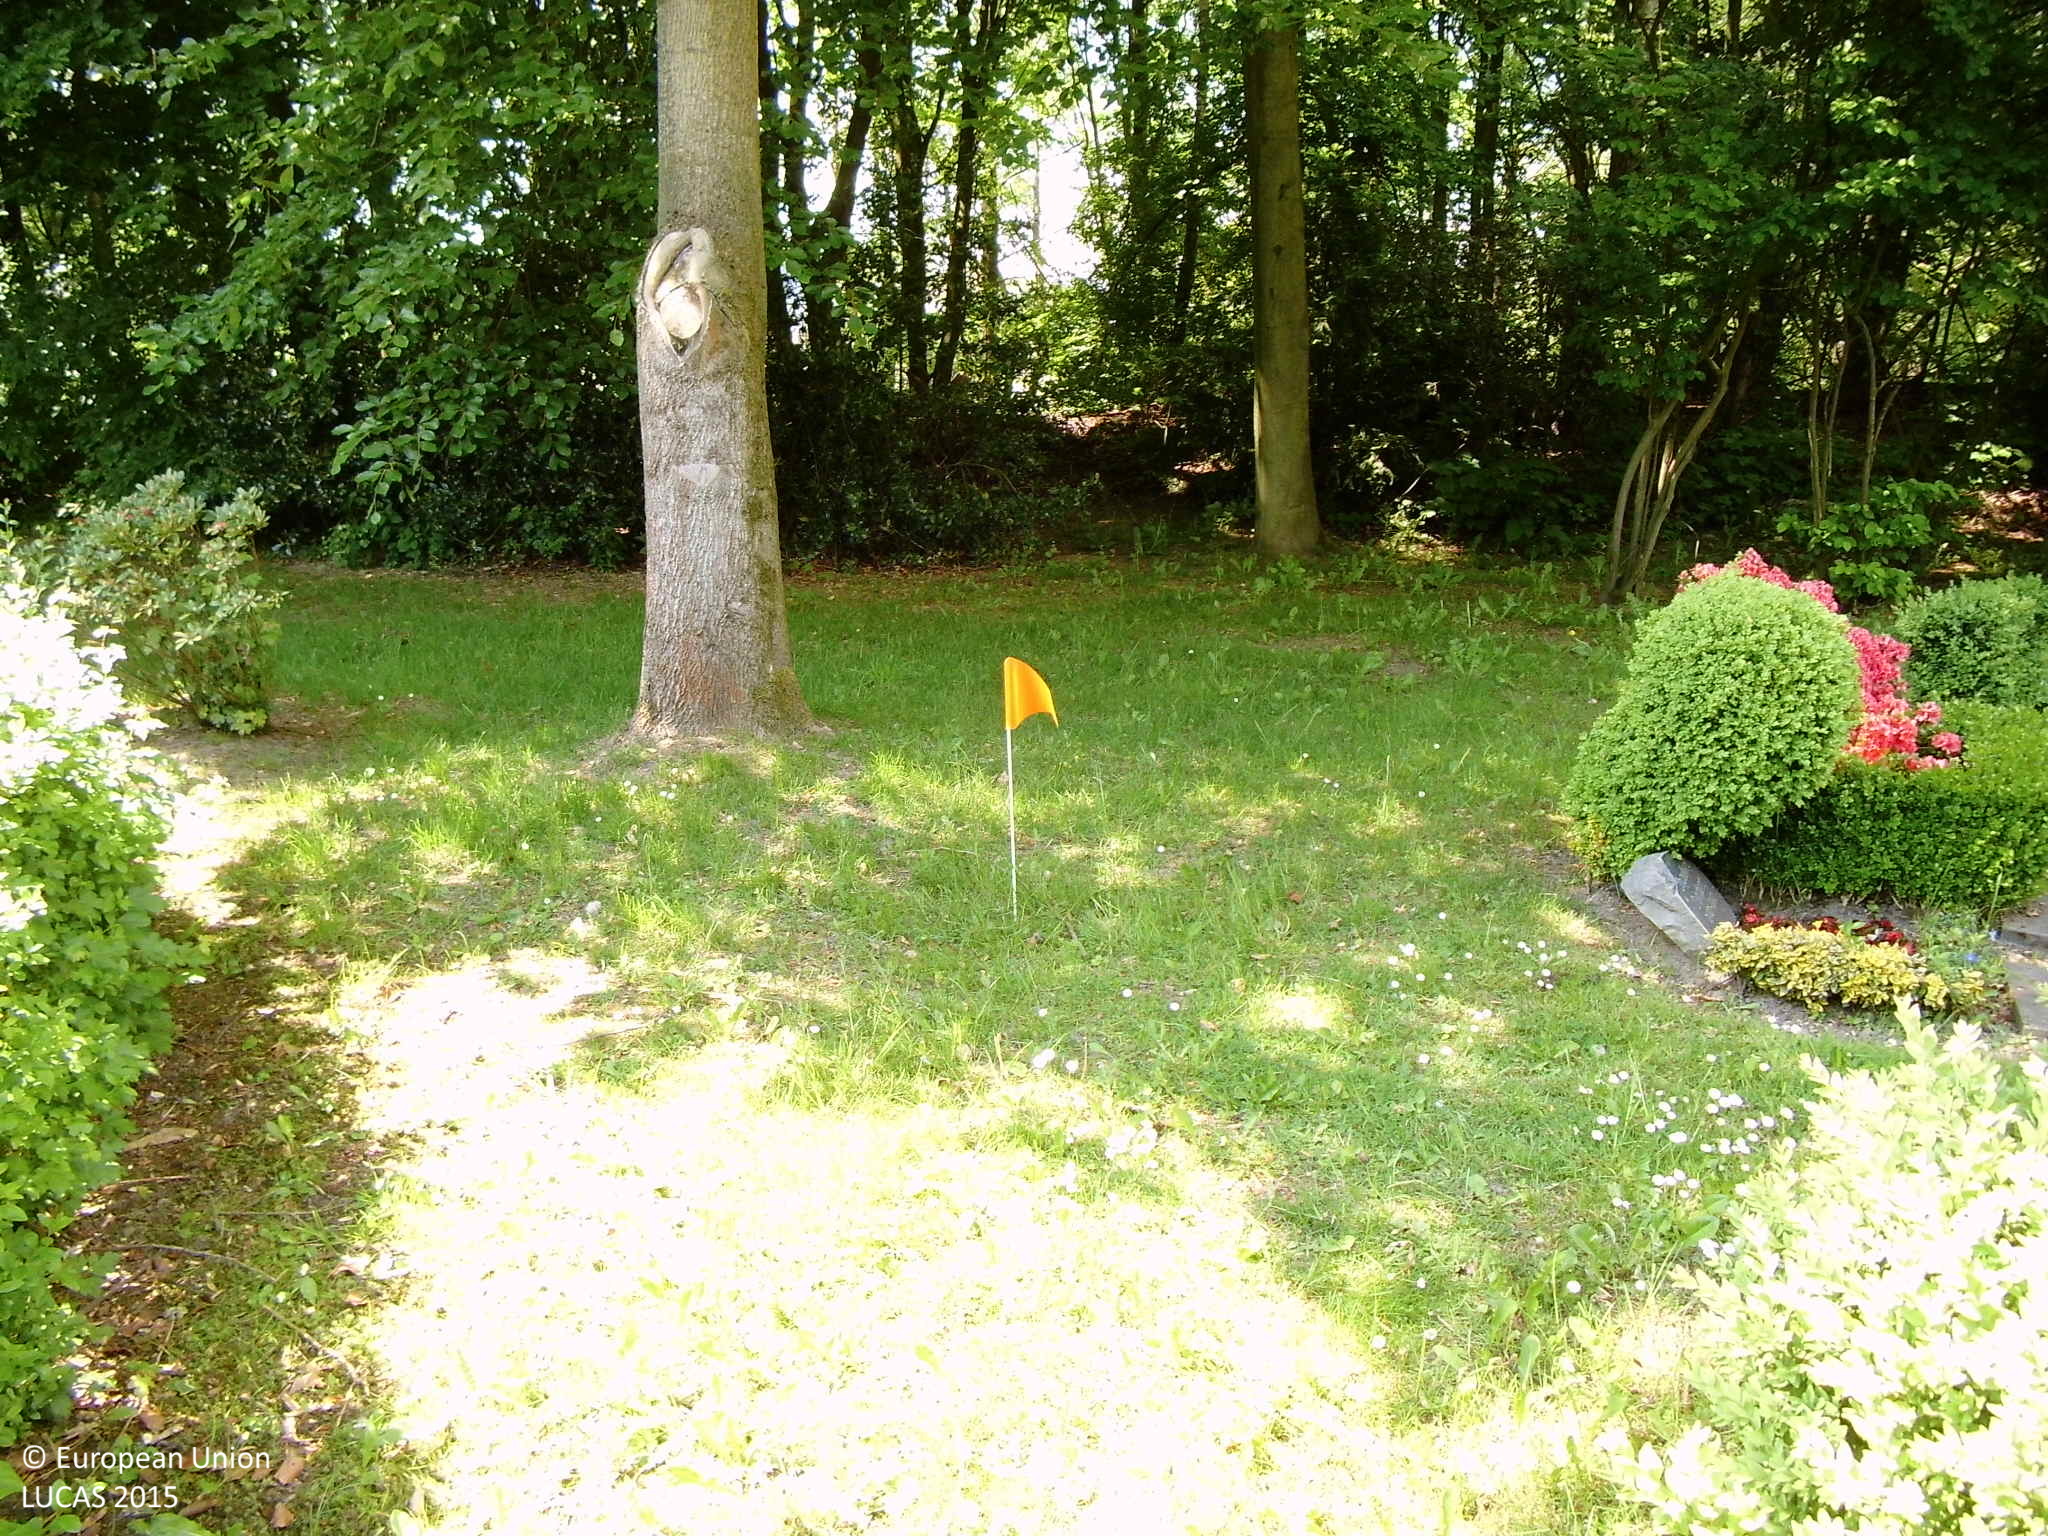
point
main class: Woodland
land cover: Broadleaved woodland
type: beech forest
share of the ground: 25 - 50 %
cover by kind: broadleaved forest trees 40 %, herbaceous plants 30 %, shrubs 20 %, consolidated bare surface 5 %, unconsolidated bare surface 5 %
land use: Community services
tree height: > 5 m
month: May
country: DE
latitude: 51.6293
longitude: 7.3854
